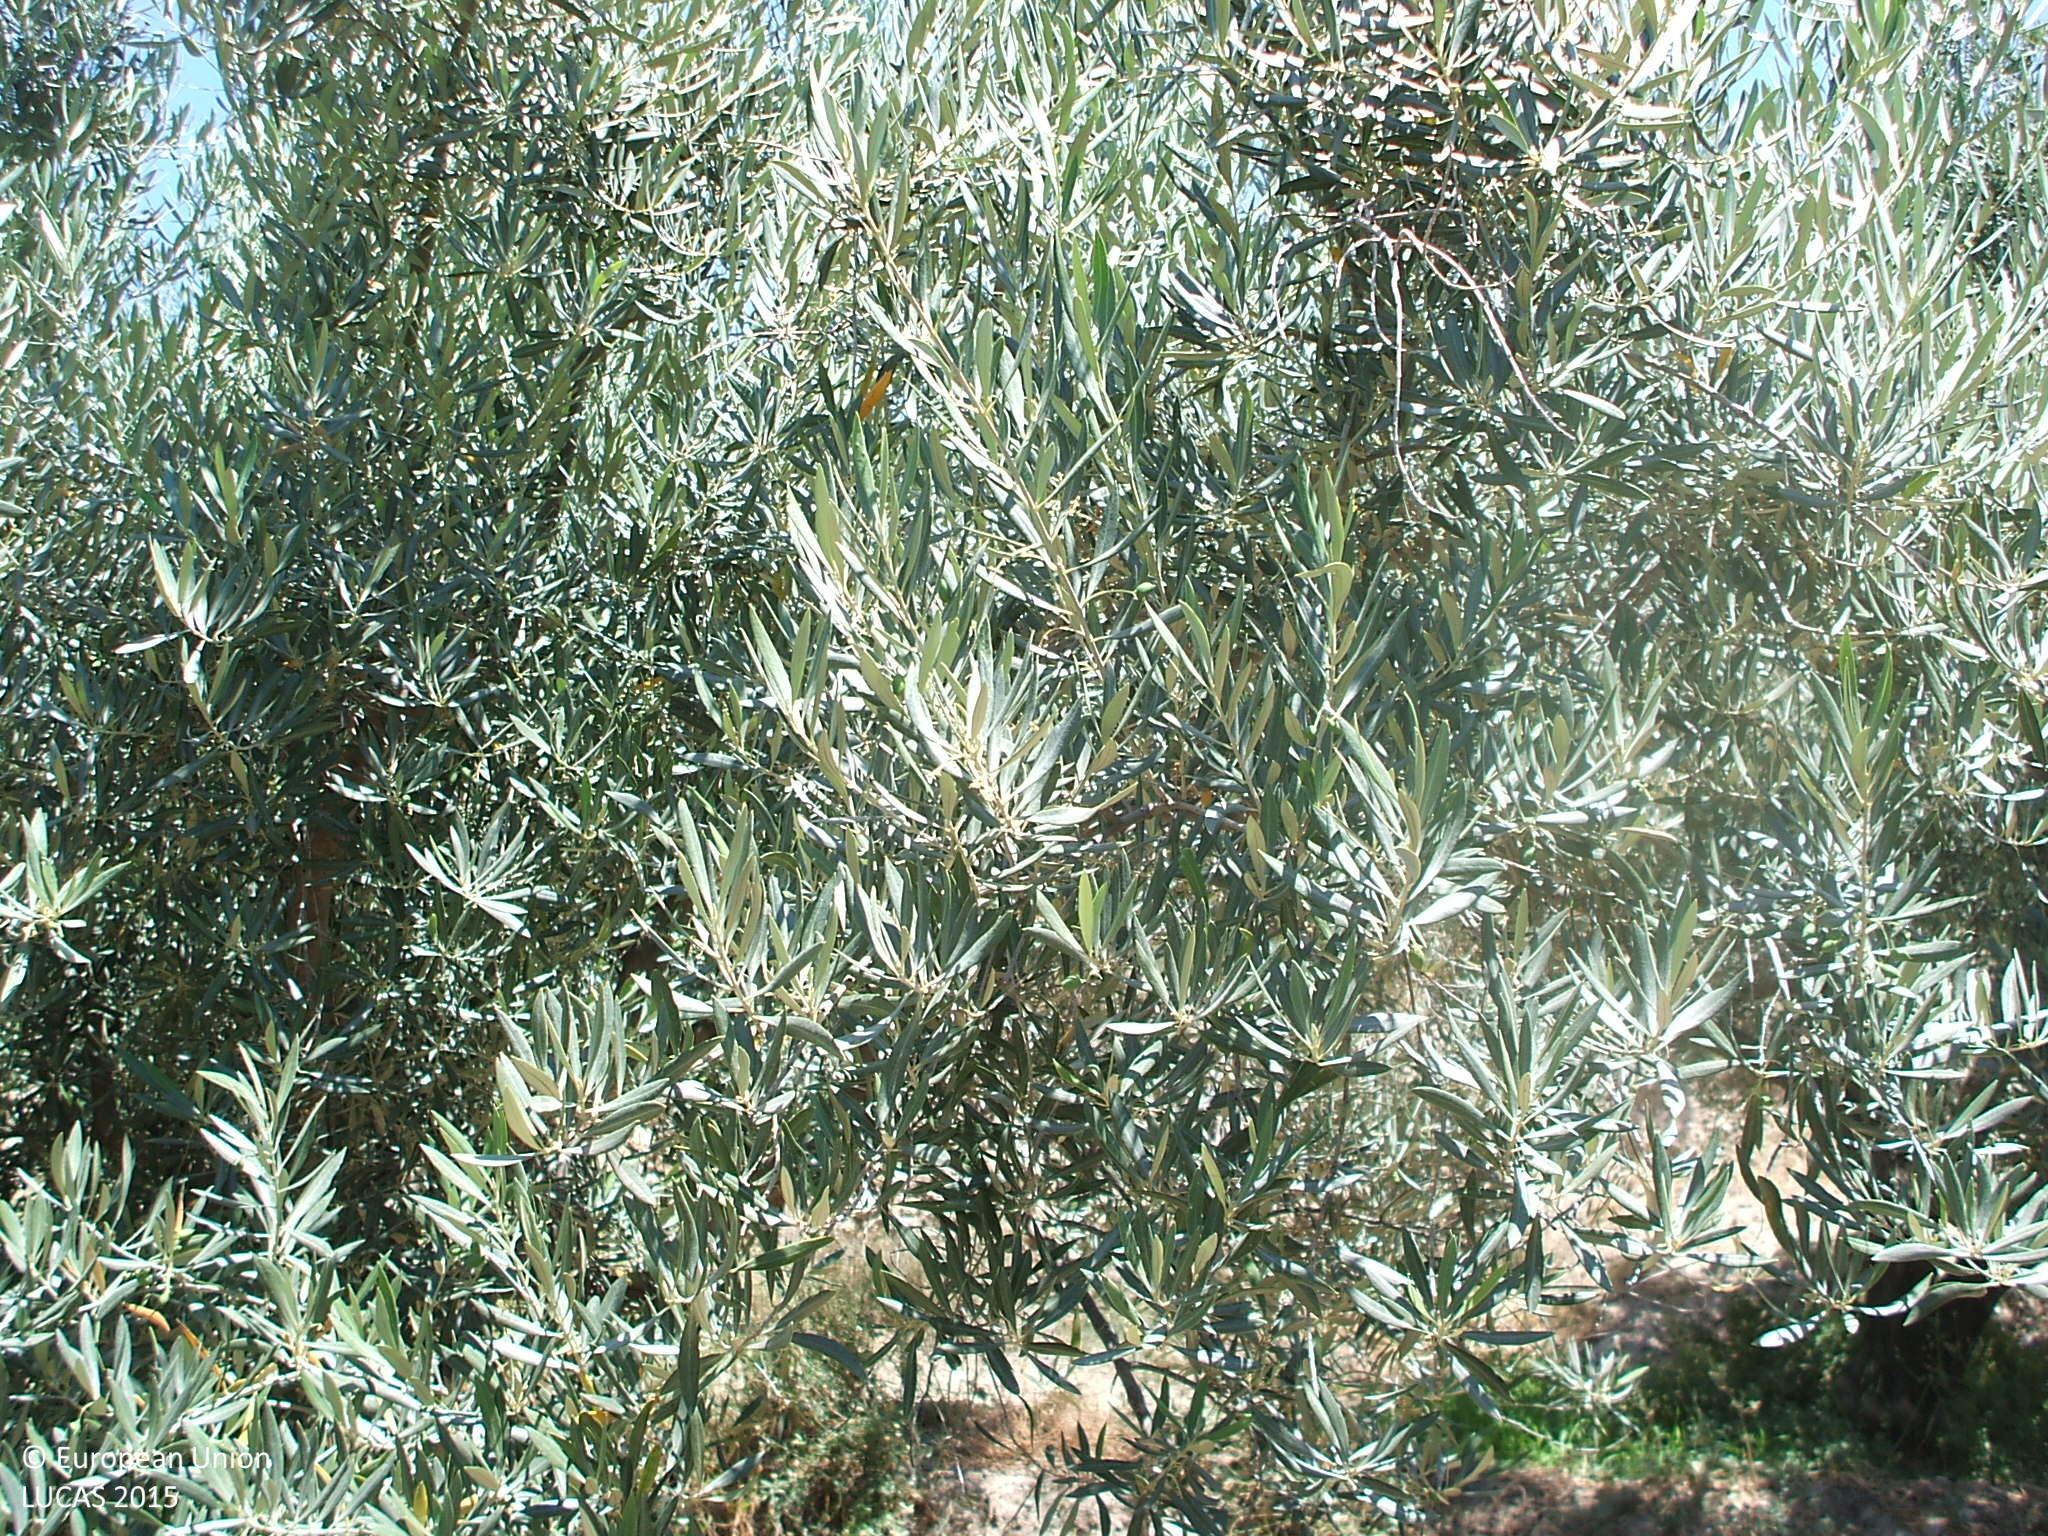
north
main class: Cropland
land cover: Olive groves
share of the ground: > 75 %
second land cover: Spontaneously vegetated surfaces
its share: 25 - 50 %
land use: Agriculture (excluding fallow land and kitchen gardens)
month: June
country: ES
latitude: 37.0127
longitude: -2.7584
